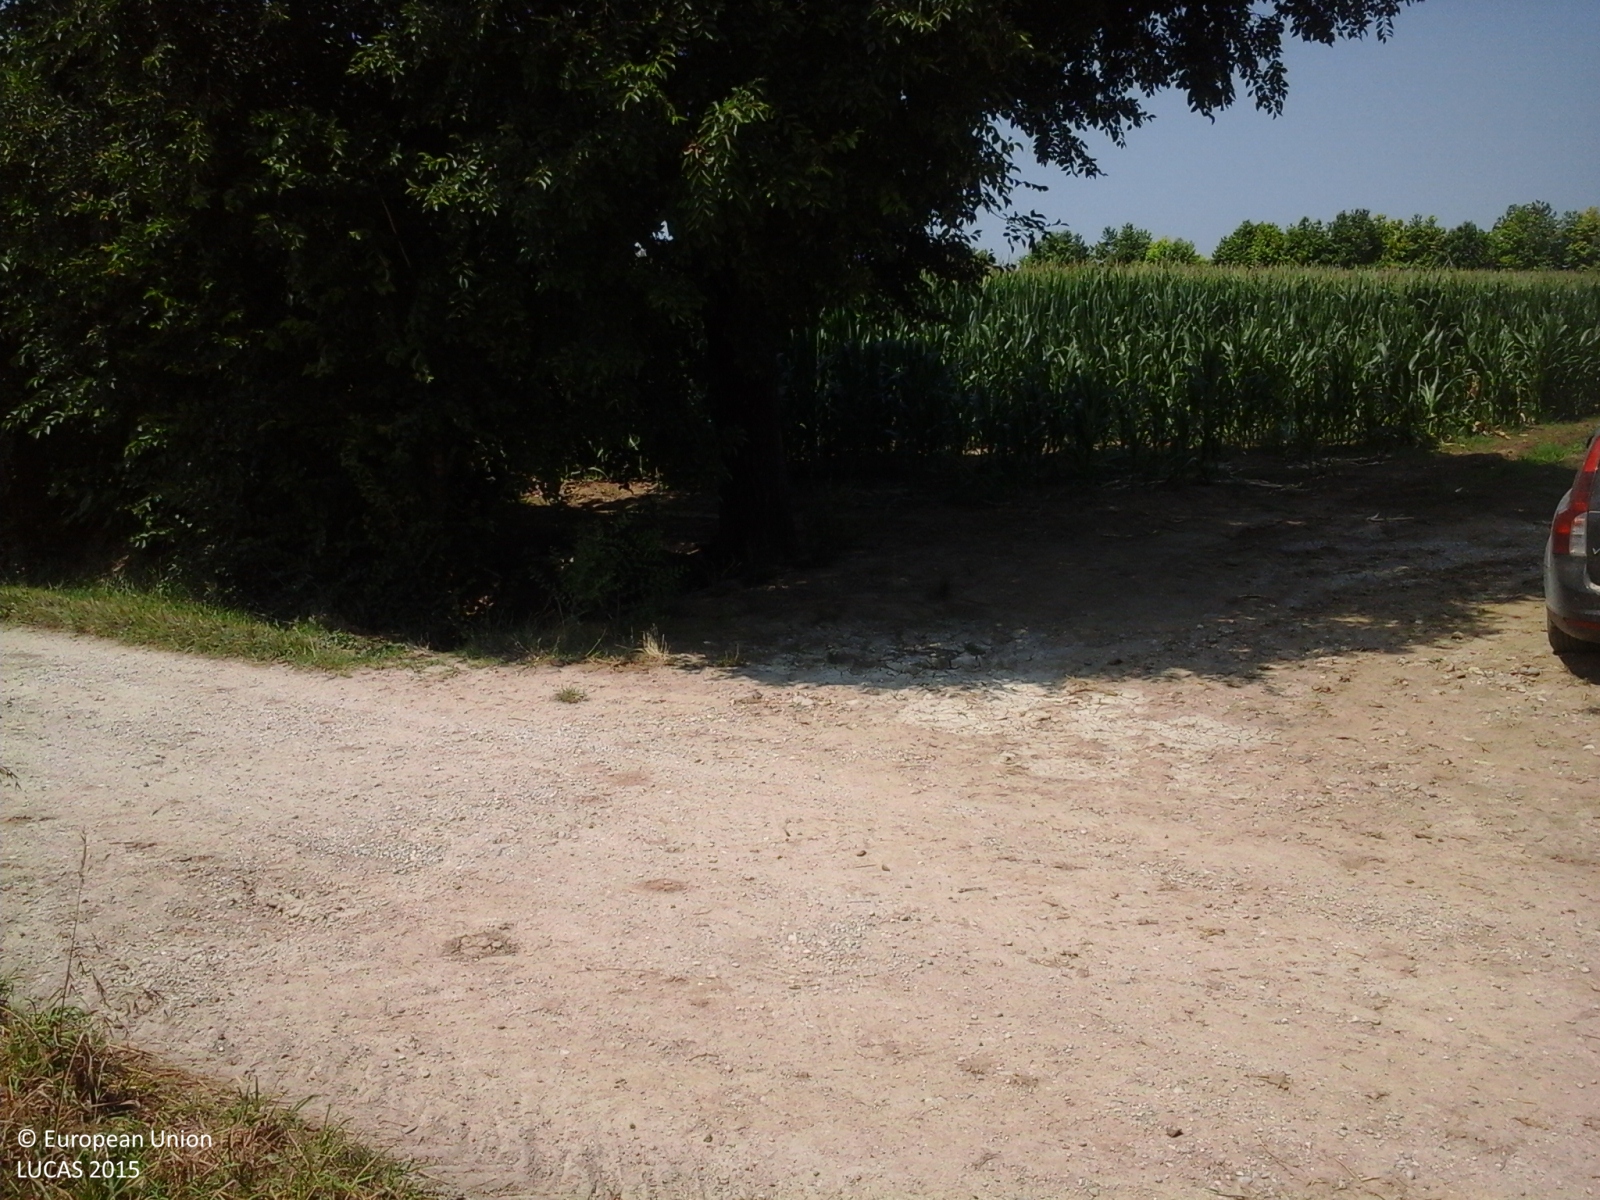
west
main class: Cropland
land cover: Maize
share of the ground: > 75 %
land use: Agriculture (excluding fallow land and kitchen gardens)
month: July
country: IT
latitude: 45.2662
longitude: 10.9033
